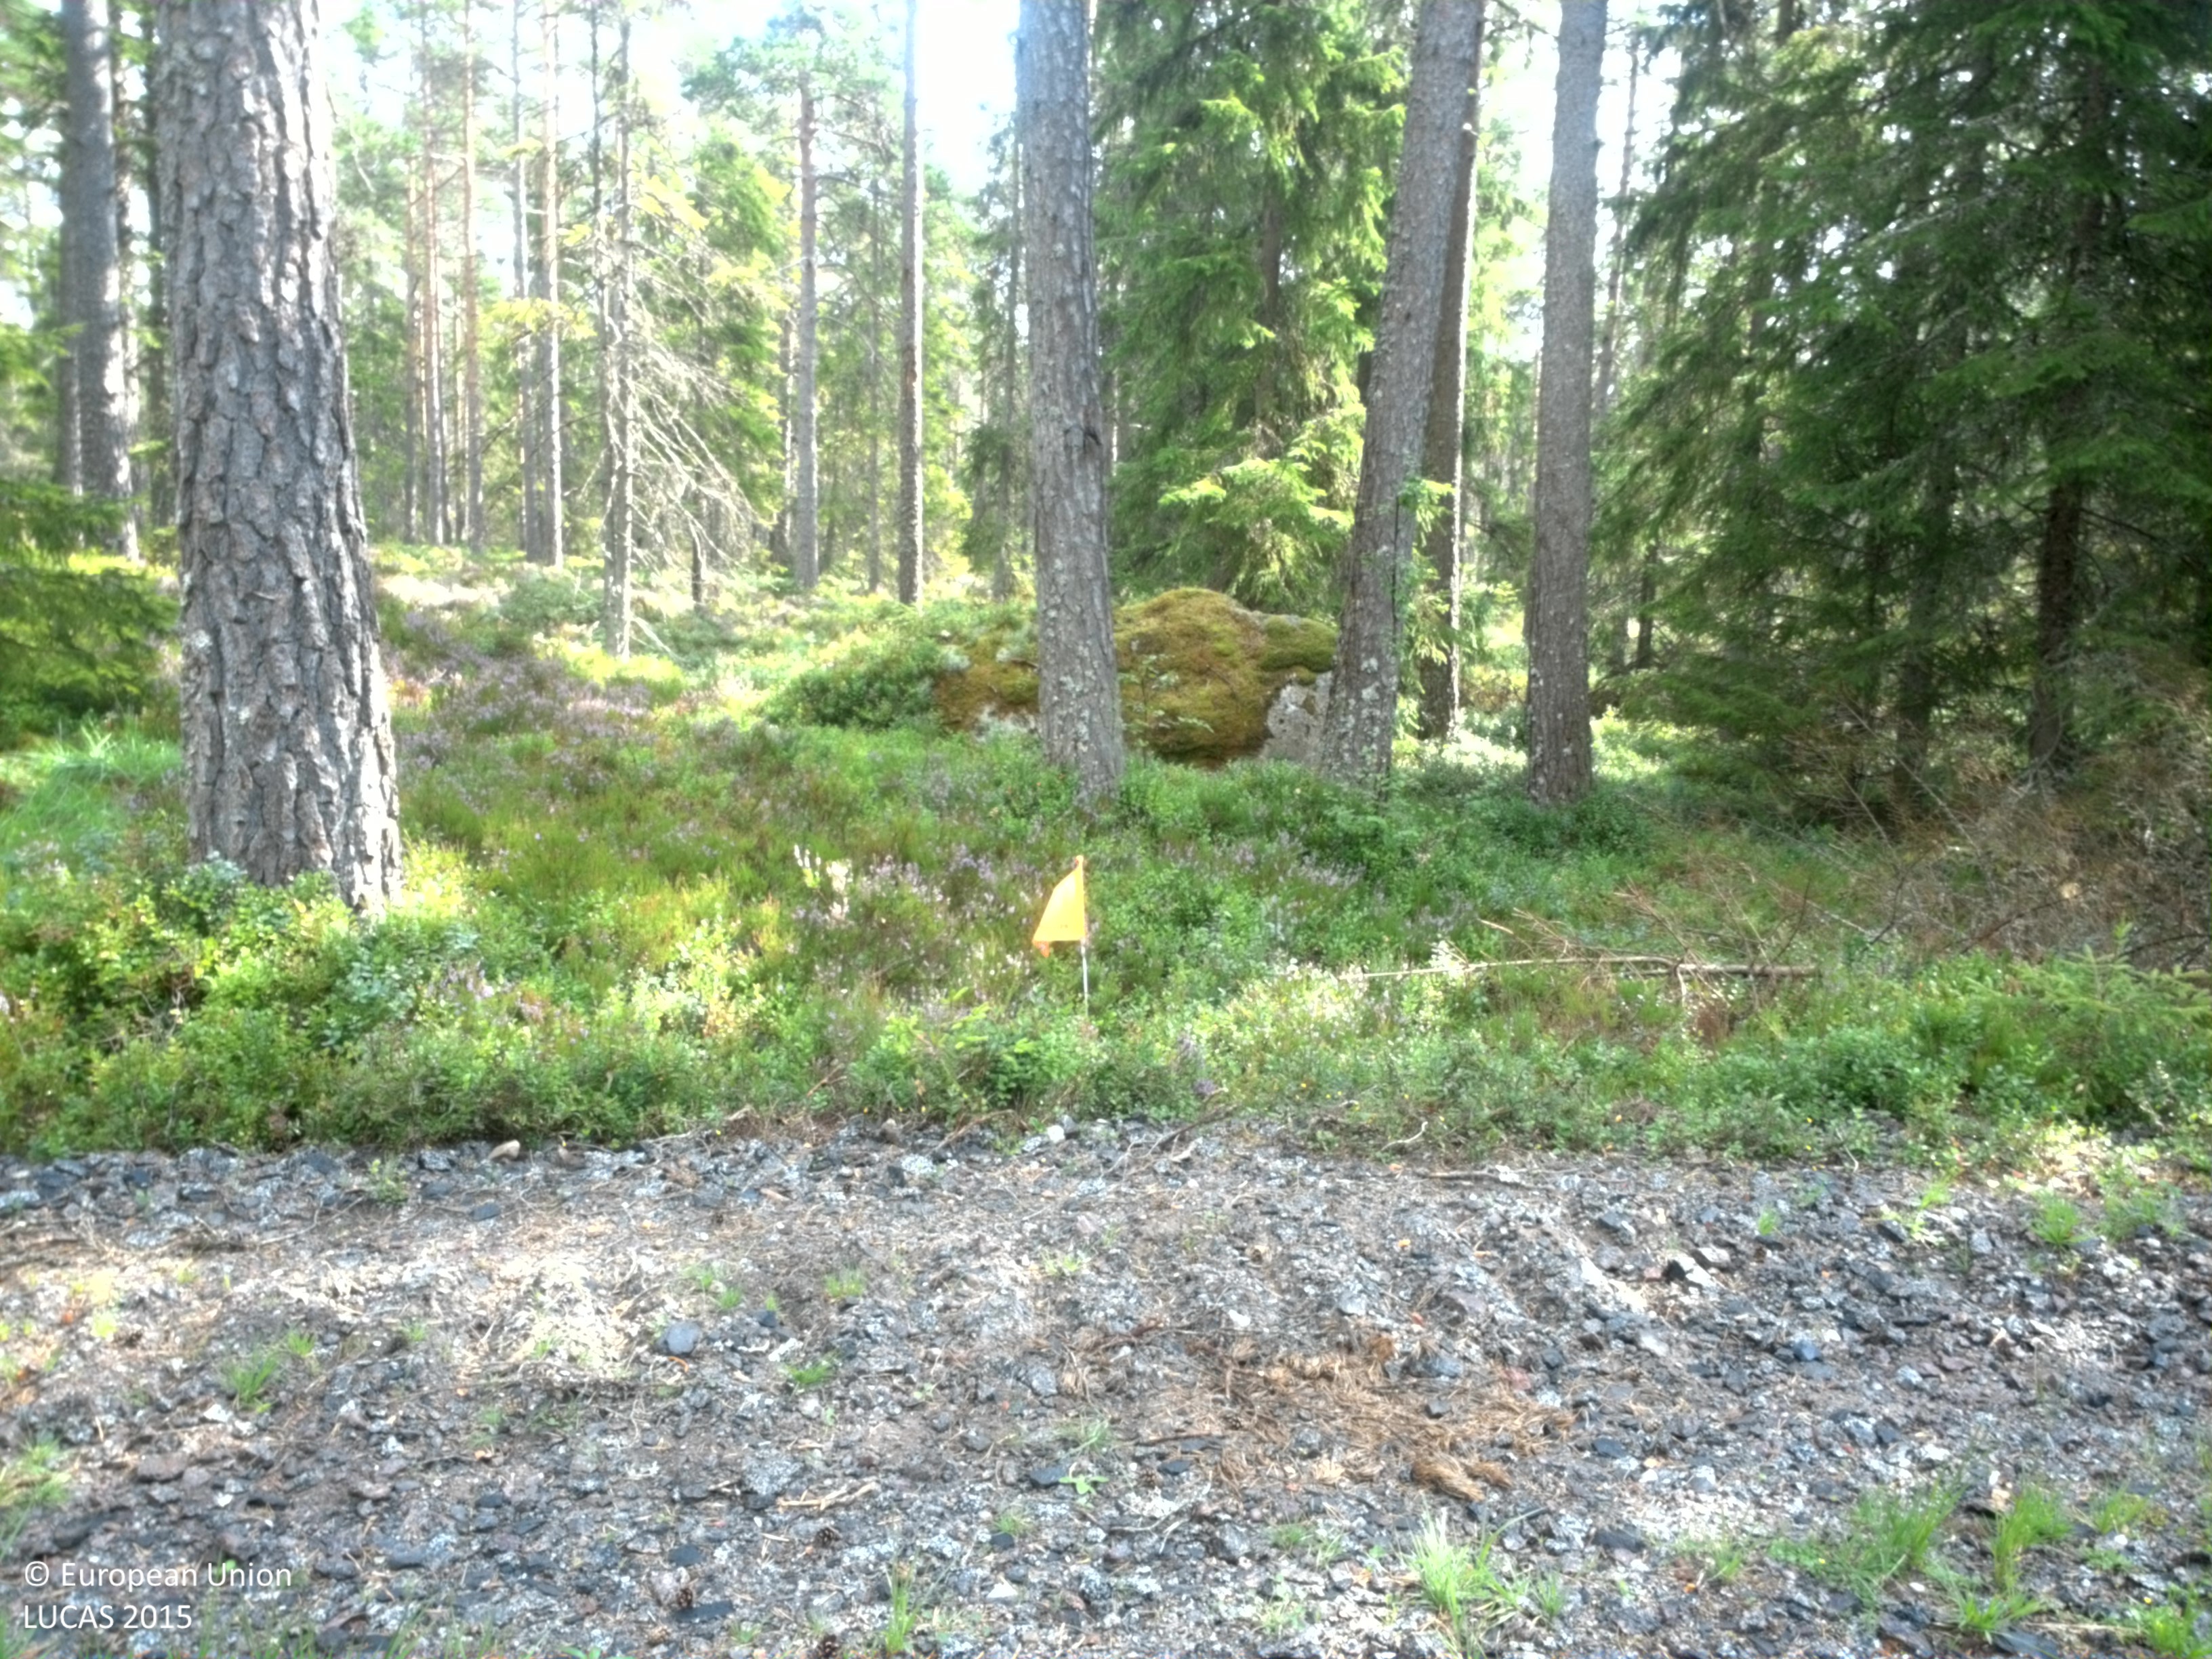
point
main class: Woodland
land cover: Pine dominated coniferous woodland
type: boreal forest
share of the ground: 25 - 50 %
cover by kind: shrubs 60 %, coniferous forest trees 40 %
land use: Forestry
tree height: > 5 m
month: August
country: SE
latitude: 57.9809
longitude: 13.9685
